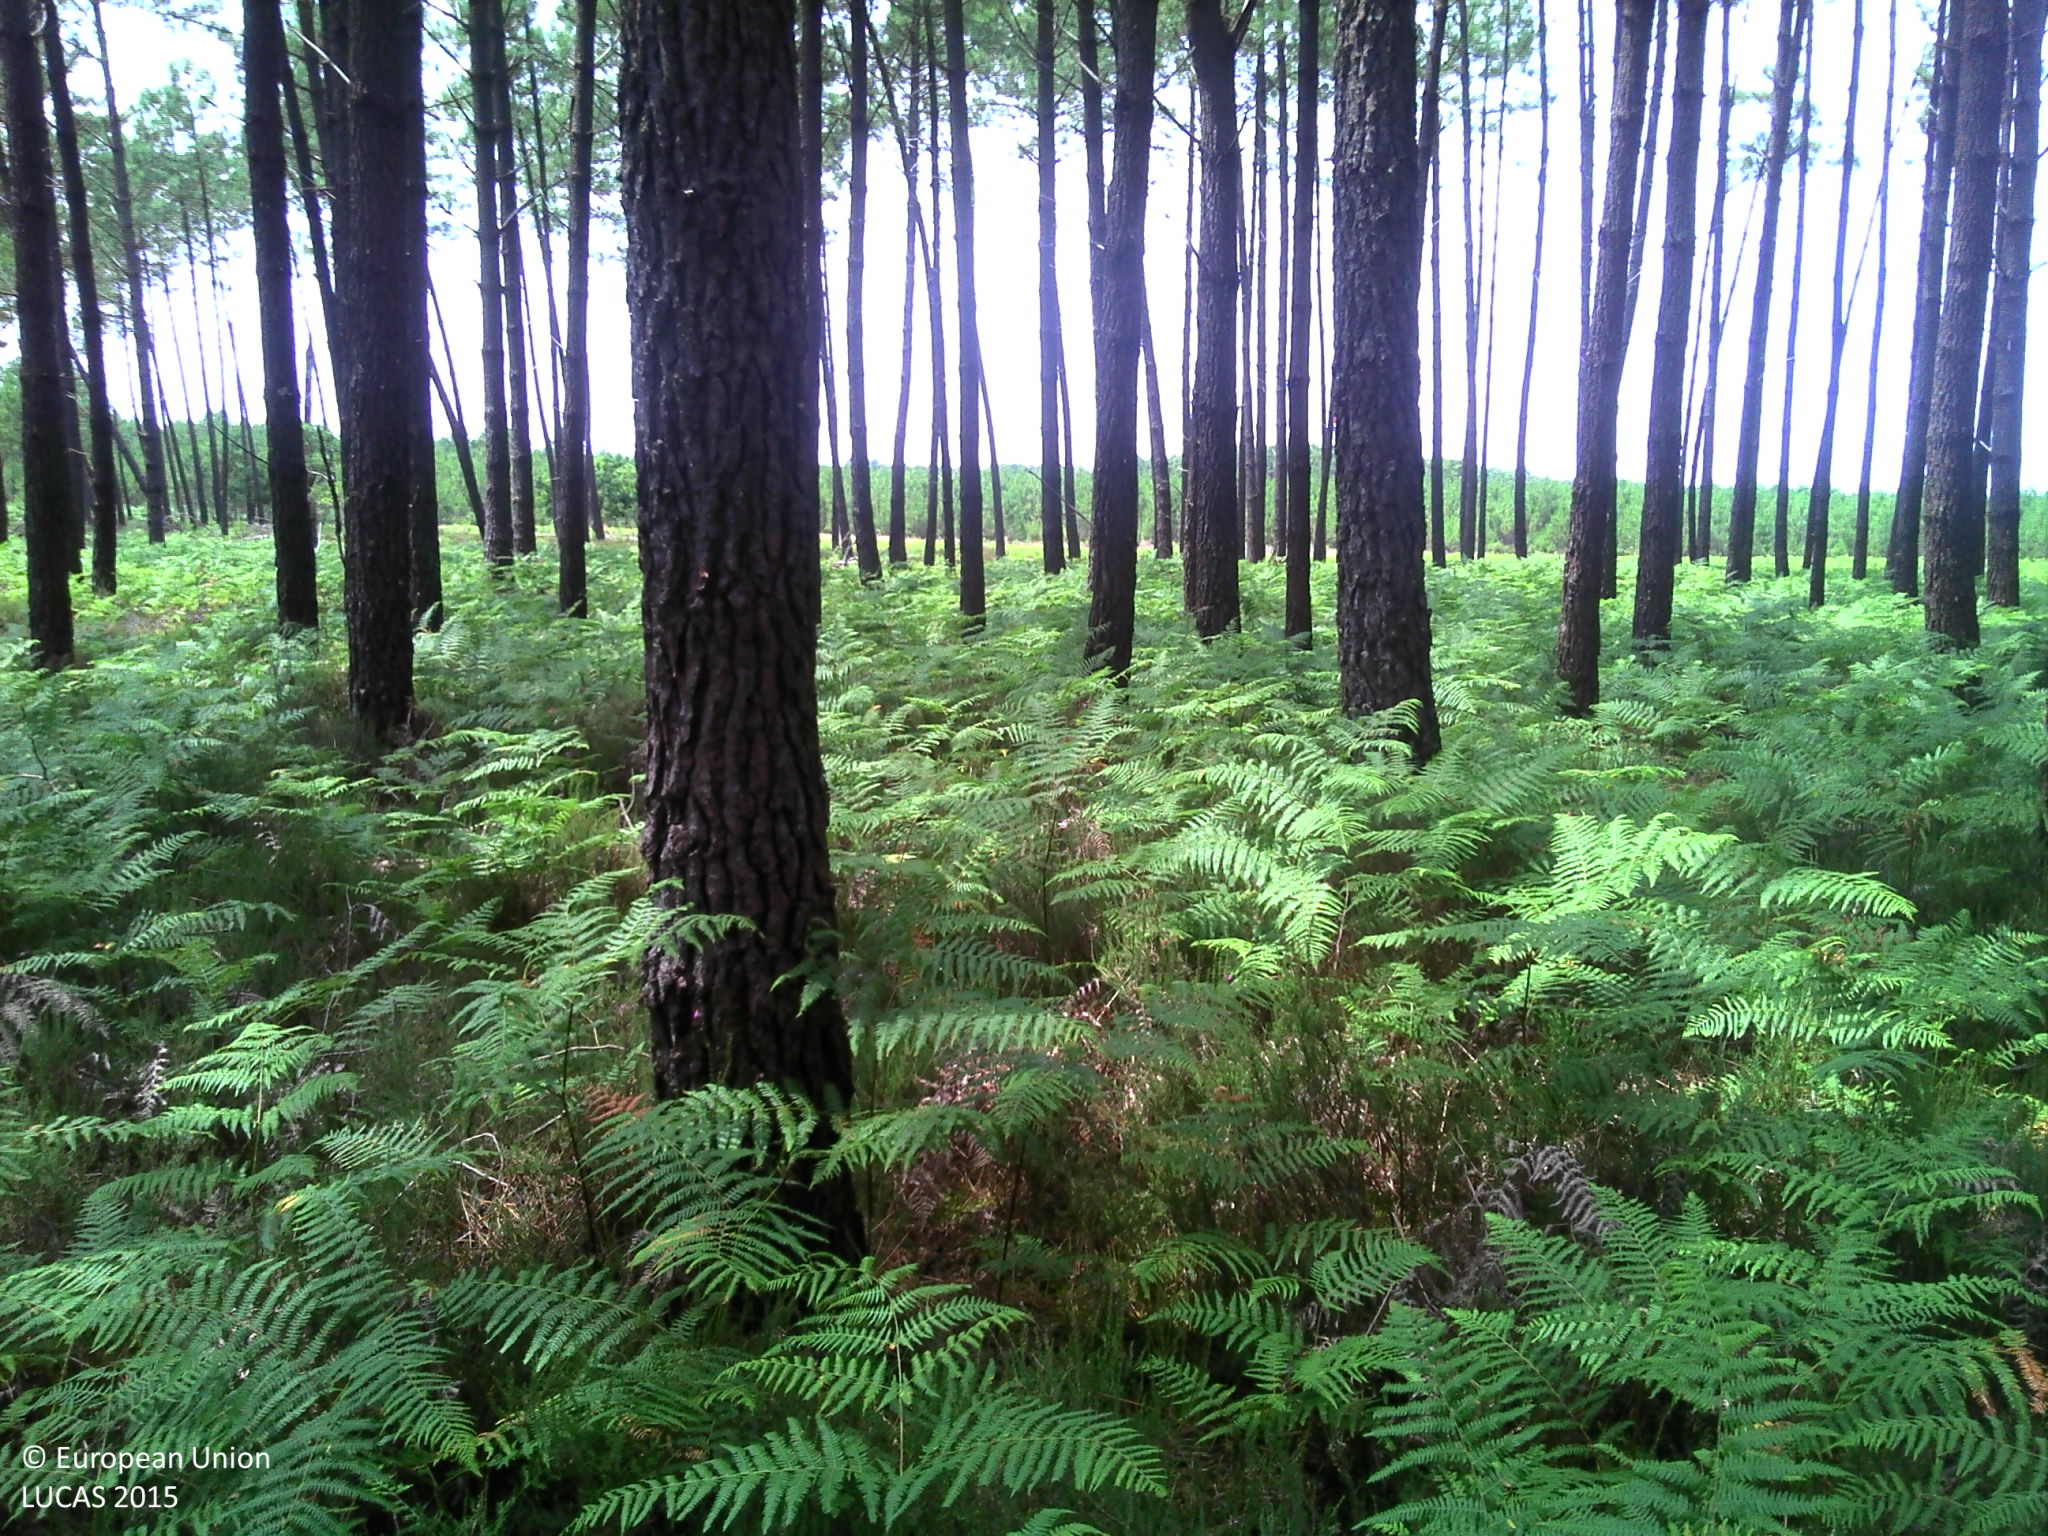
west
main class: Woodland
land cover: Pine dominated coniferous woodland
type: coniferous forest of the mediterranean region
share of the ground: > 75 %
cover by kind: coniferous forest trees 90 %, herbaceous plants 10 %
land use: Forestry
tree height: > 5 m
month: July
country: FR
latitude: 43.8486
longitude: -1.2262
